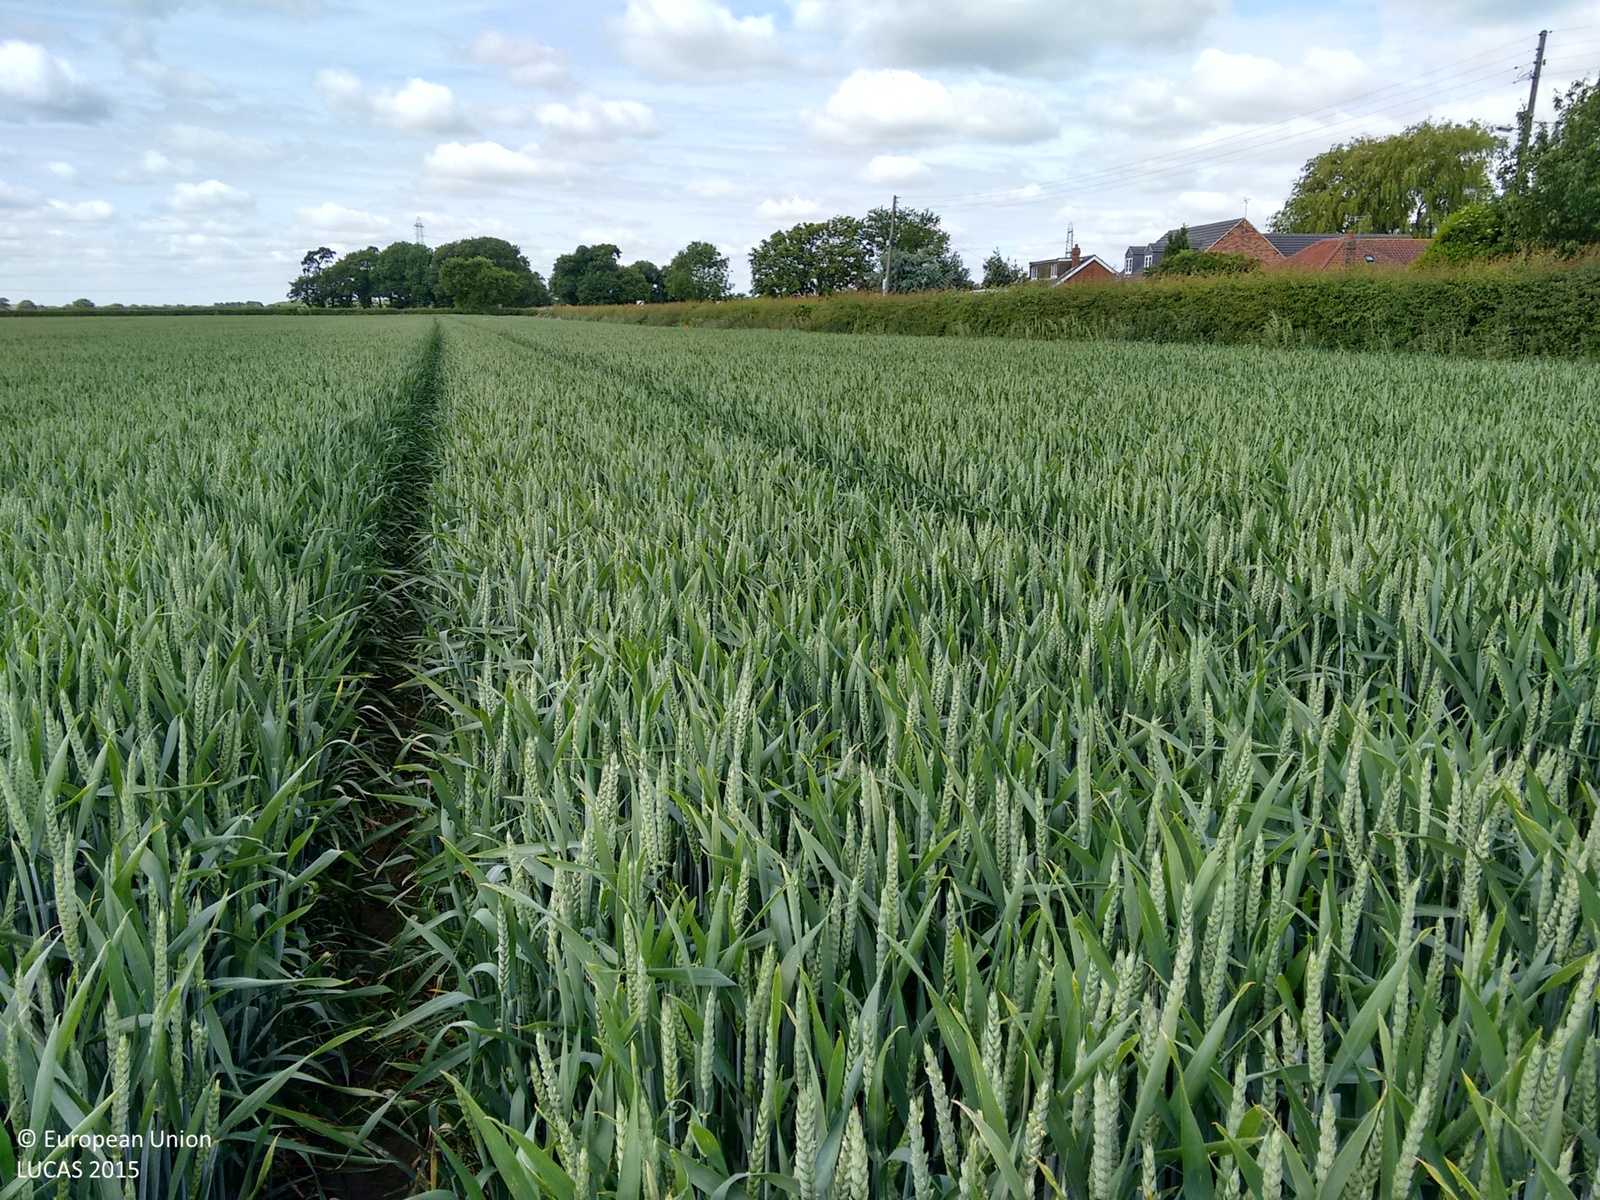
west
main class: Cropland
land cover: Common wheat
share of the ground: > 75 %
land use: Agriculture (excluding fallow land and kitchen gardens)
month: June
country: GB
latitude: 53.2559
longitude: -0.6670
